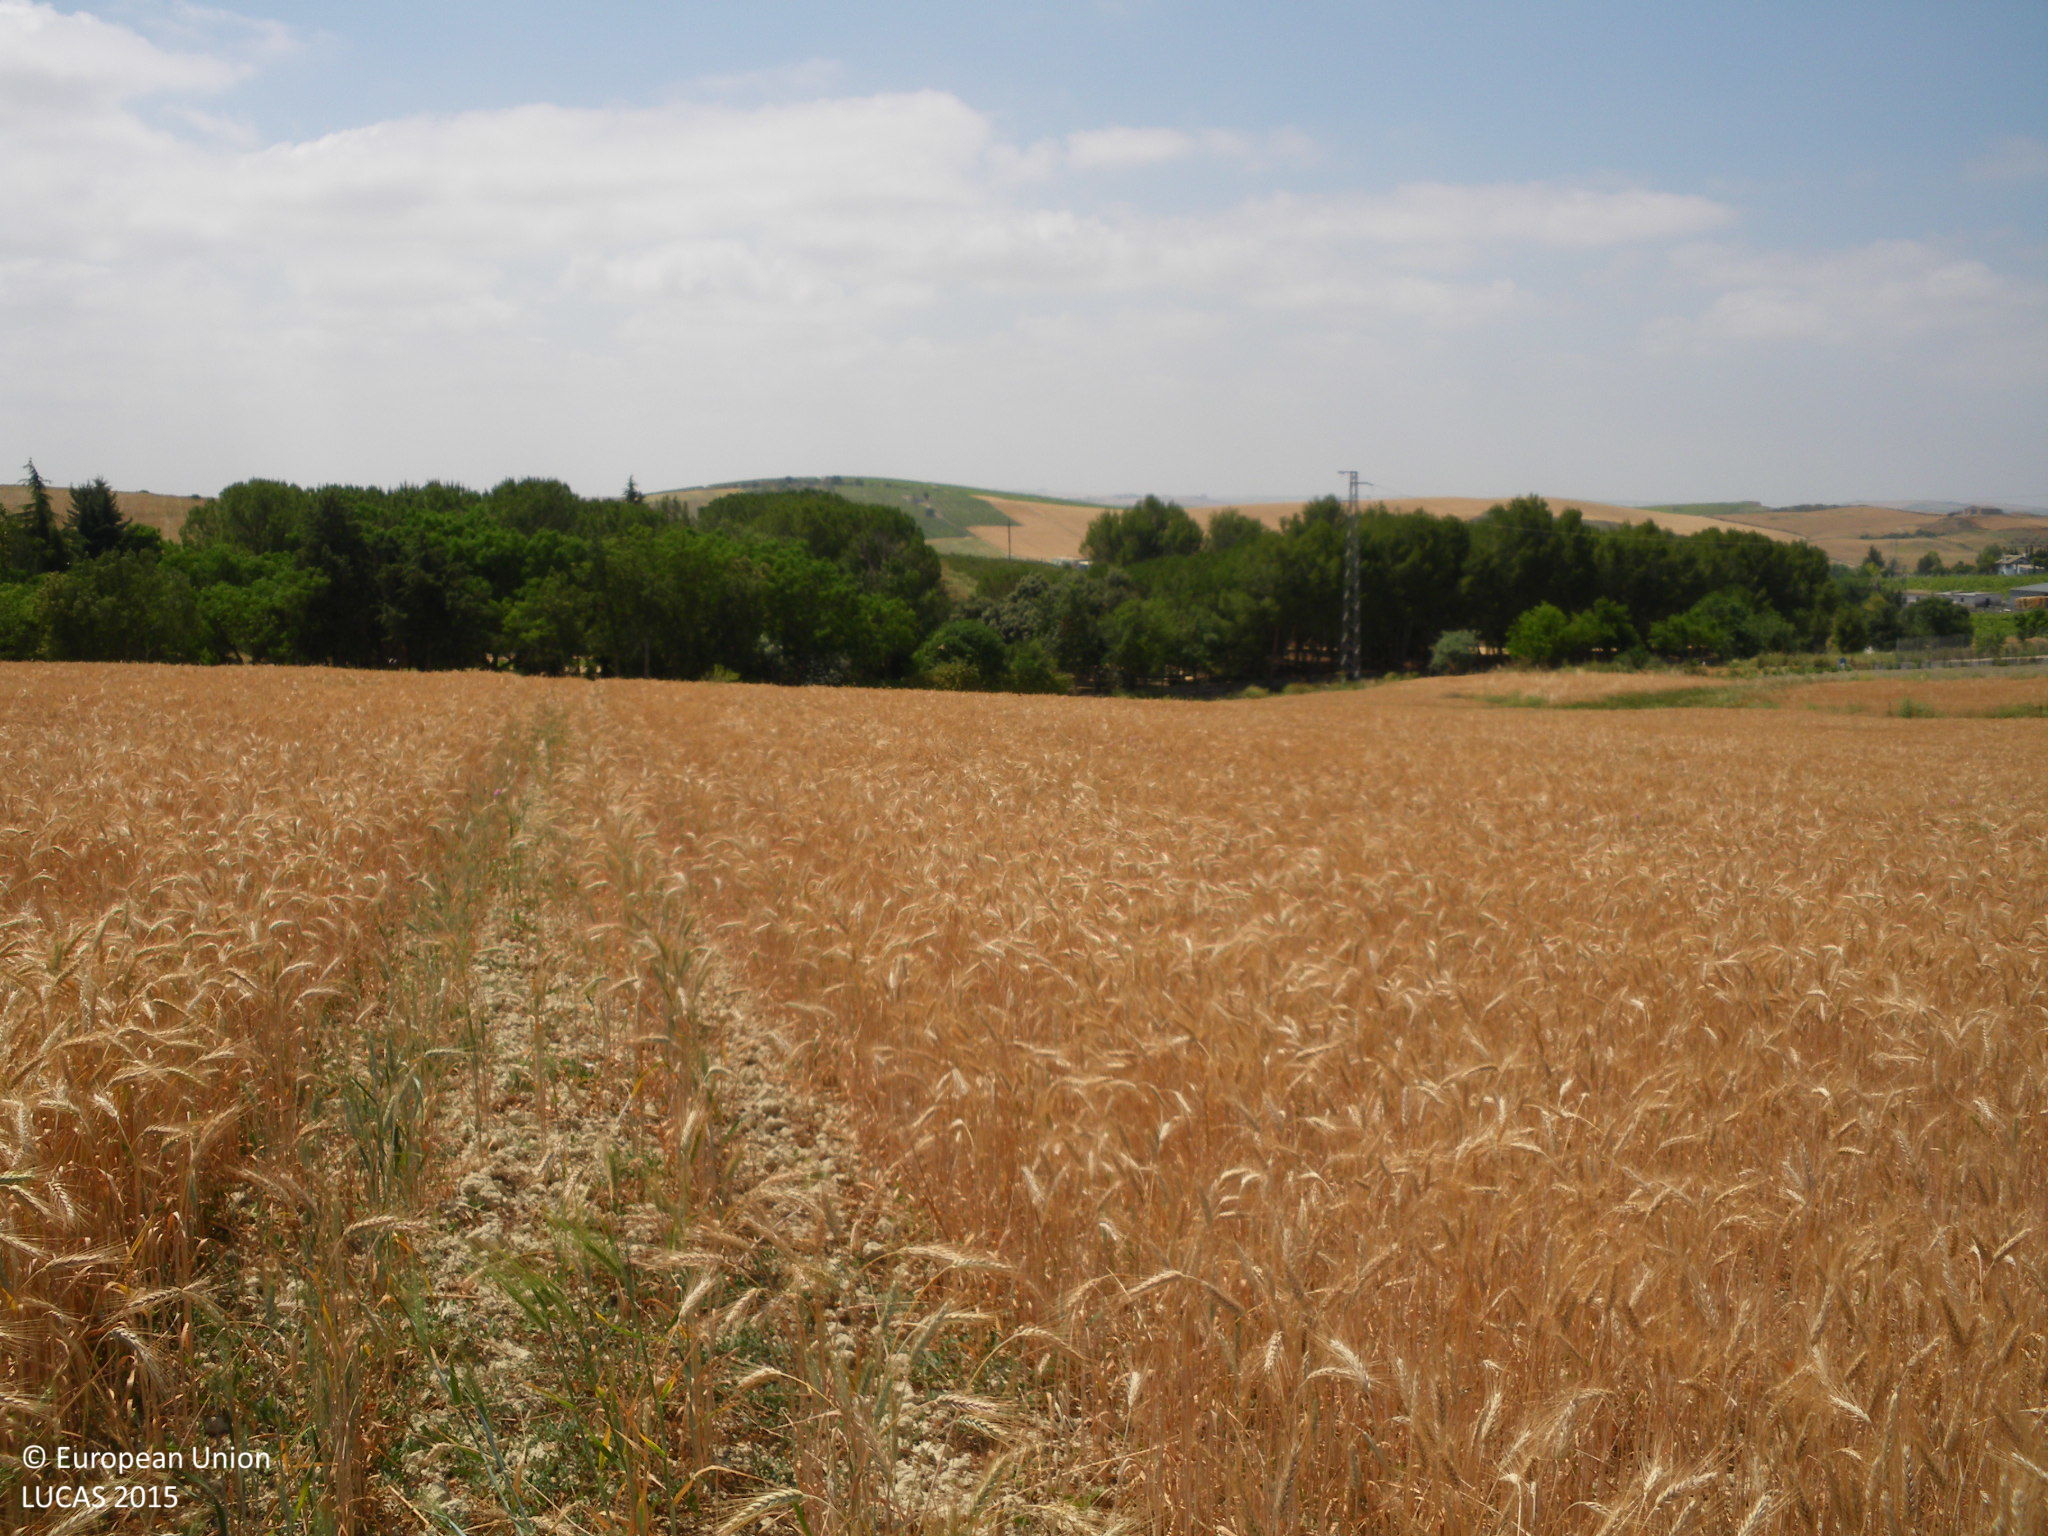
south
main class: Cropland
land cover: Triticale
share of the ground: 10 - 25 %
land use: Agriculture (excluding fallow land and kitchen gardens)
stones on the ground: < 10 %
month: May
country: ES
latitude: 36.8683
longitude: -6.1814
